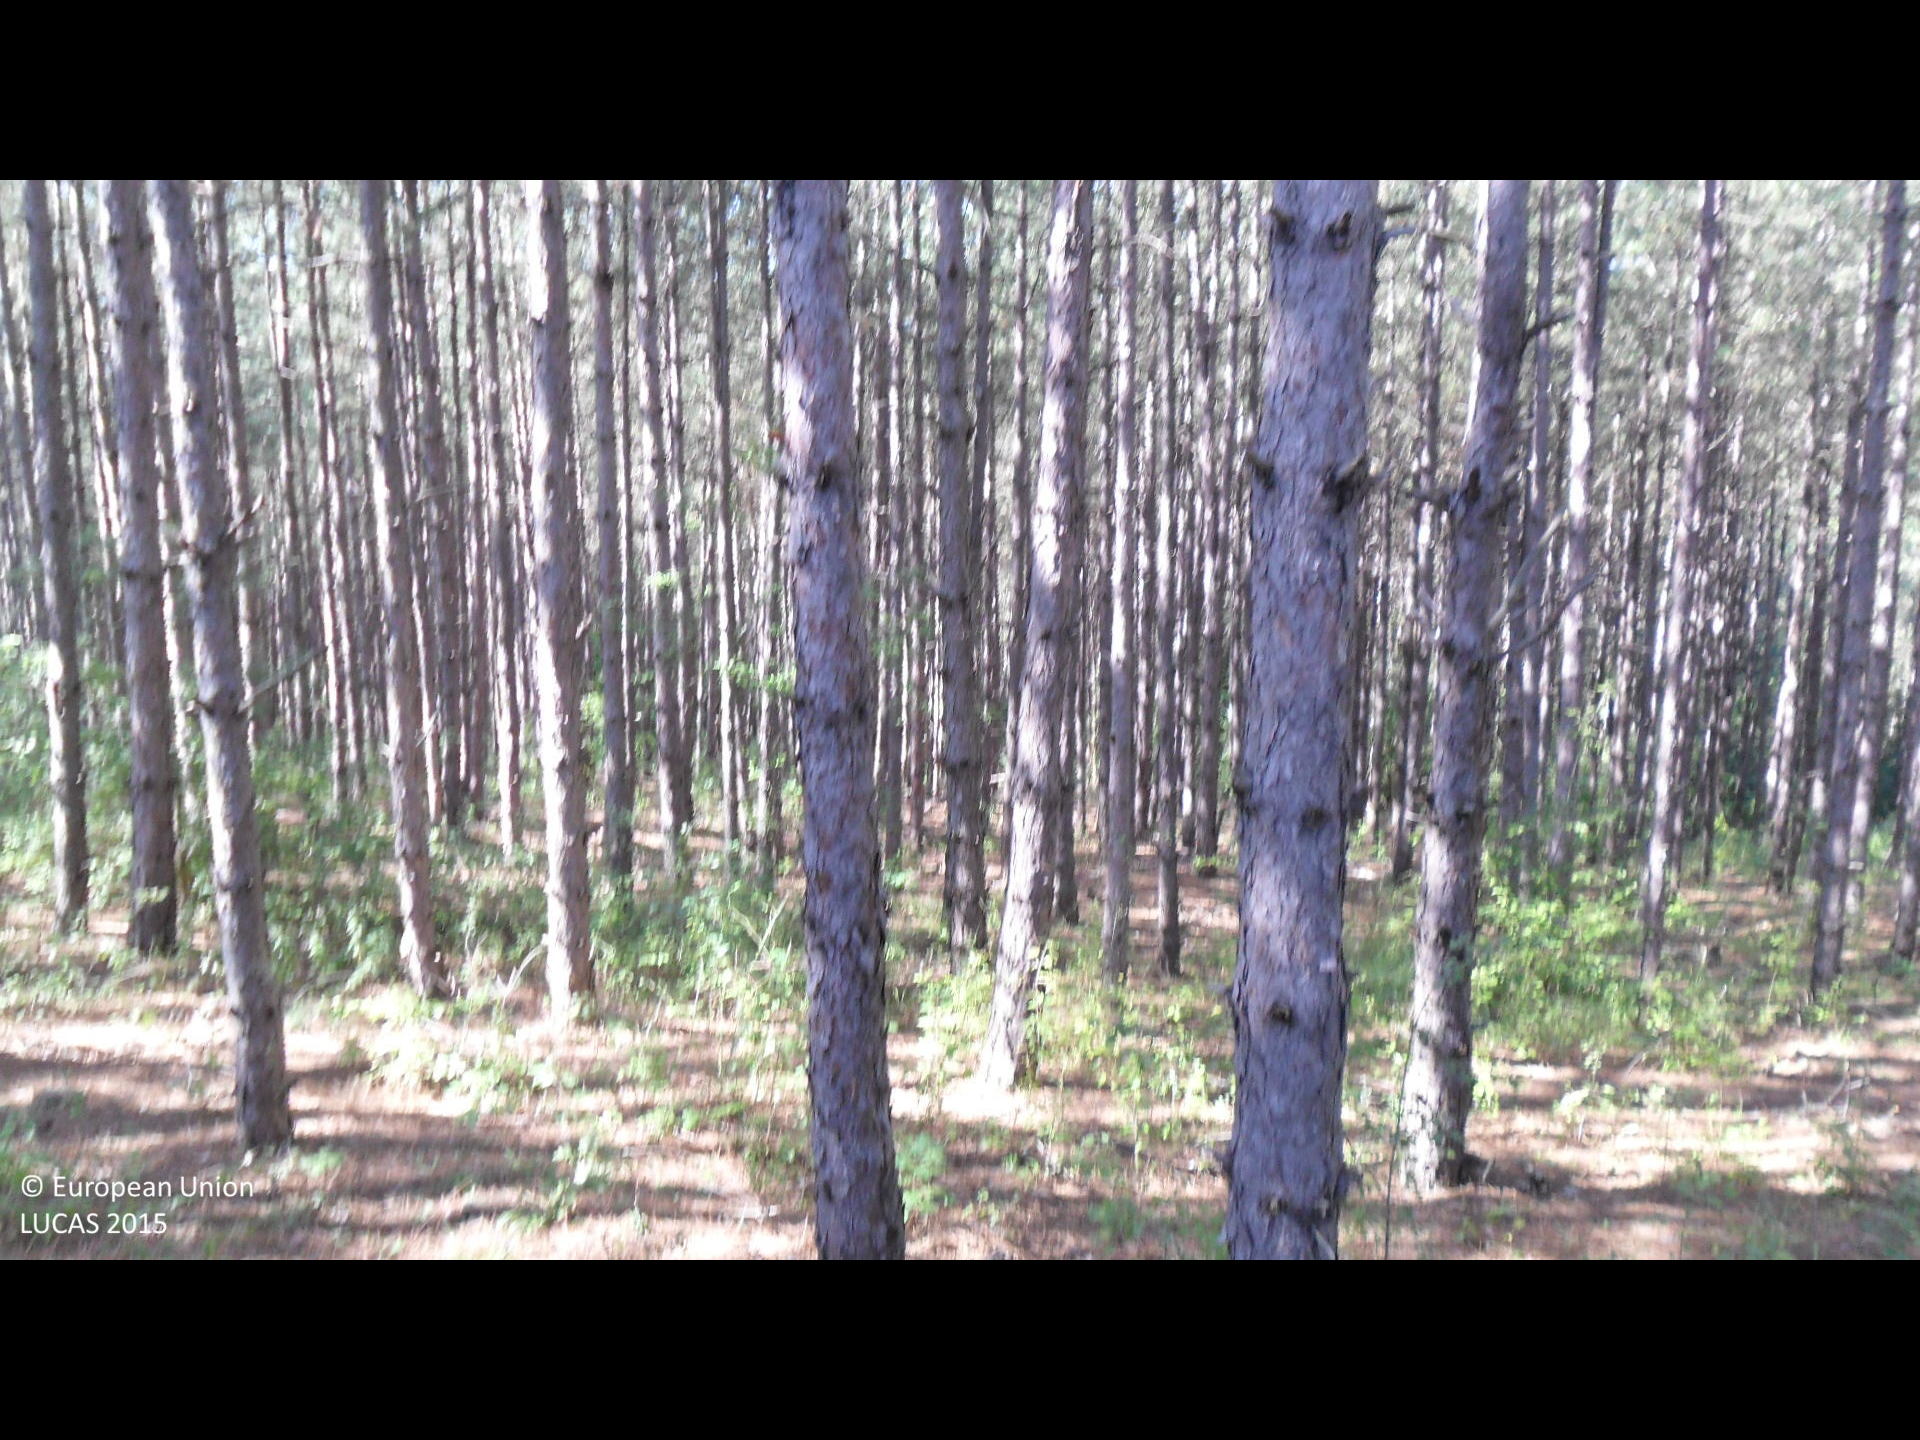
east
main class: Woodland
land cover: Pine dominated coniferous woodland
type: hemiboreal forest and nemoral coniferous forest and mixed broadleaved-coniferous forest
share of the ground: > 75 %
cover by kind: coniferous forest trees 90 %, unconsolidated bare surface 10 %
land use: Forestry
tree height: > 5 m
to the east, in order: Pine dominated coniferous woodland; Grassland with sparse tree/shrub cover; Sunflower
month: September
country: BG
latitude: 43.0451
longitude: 26.5624
